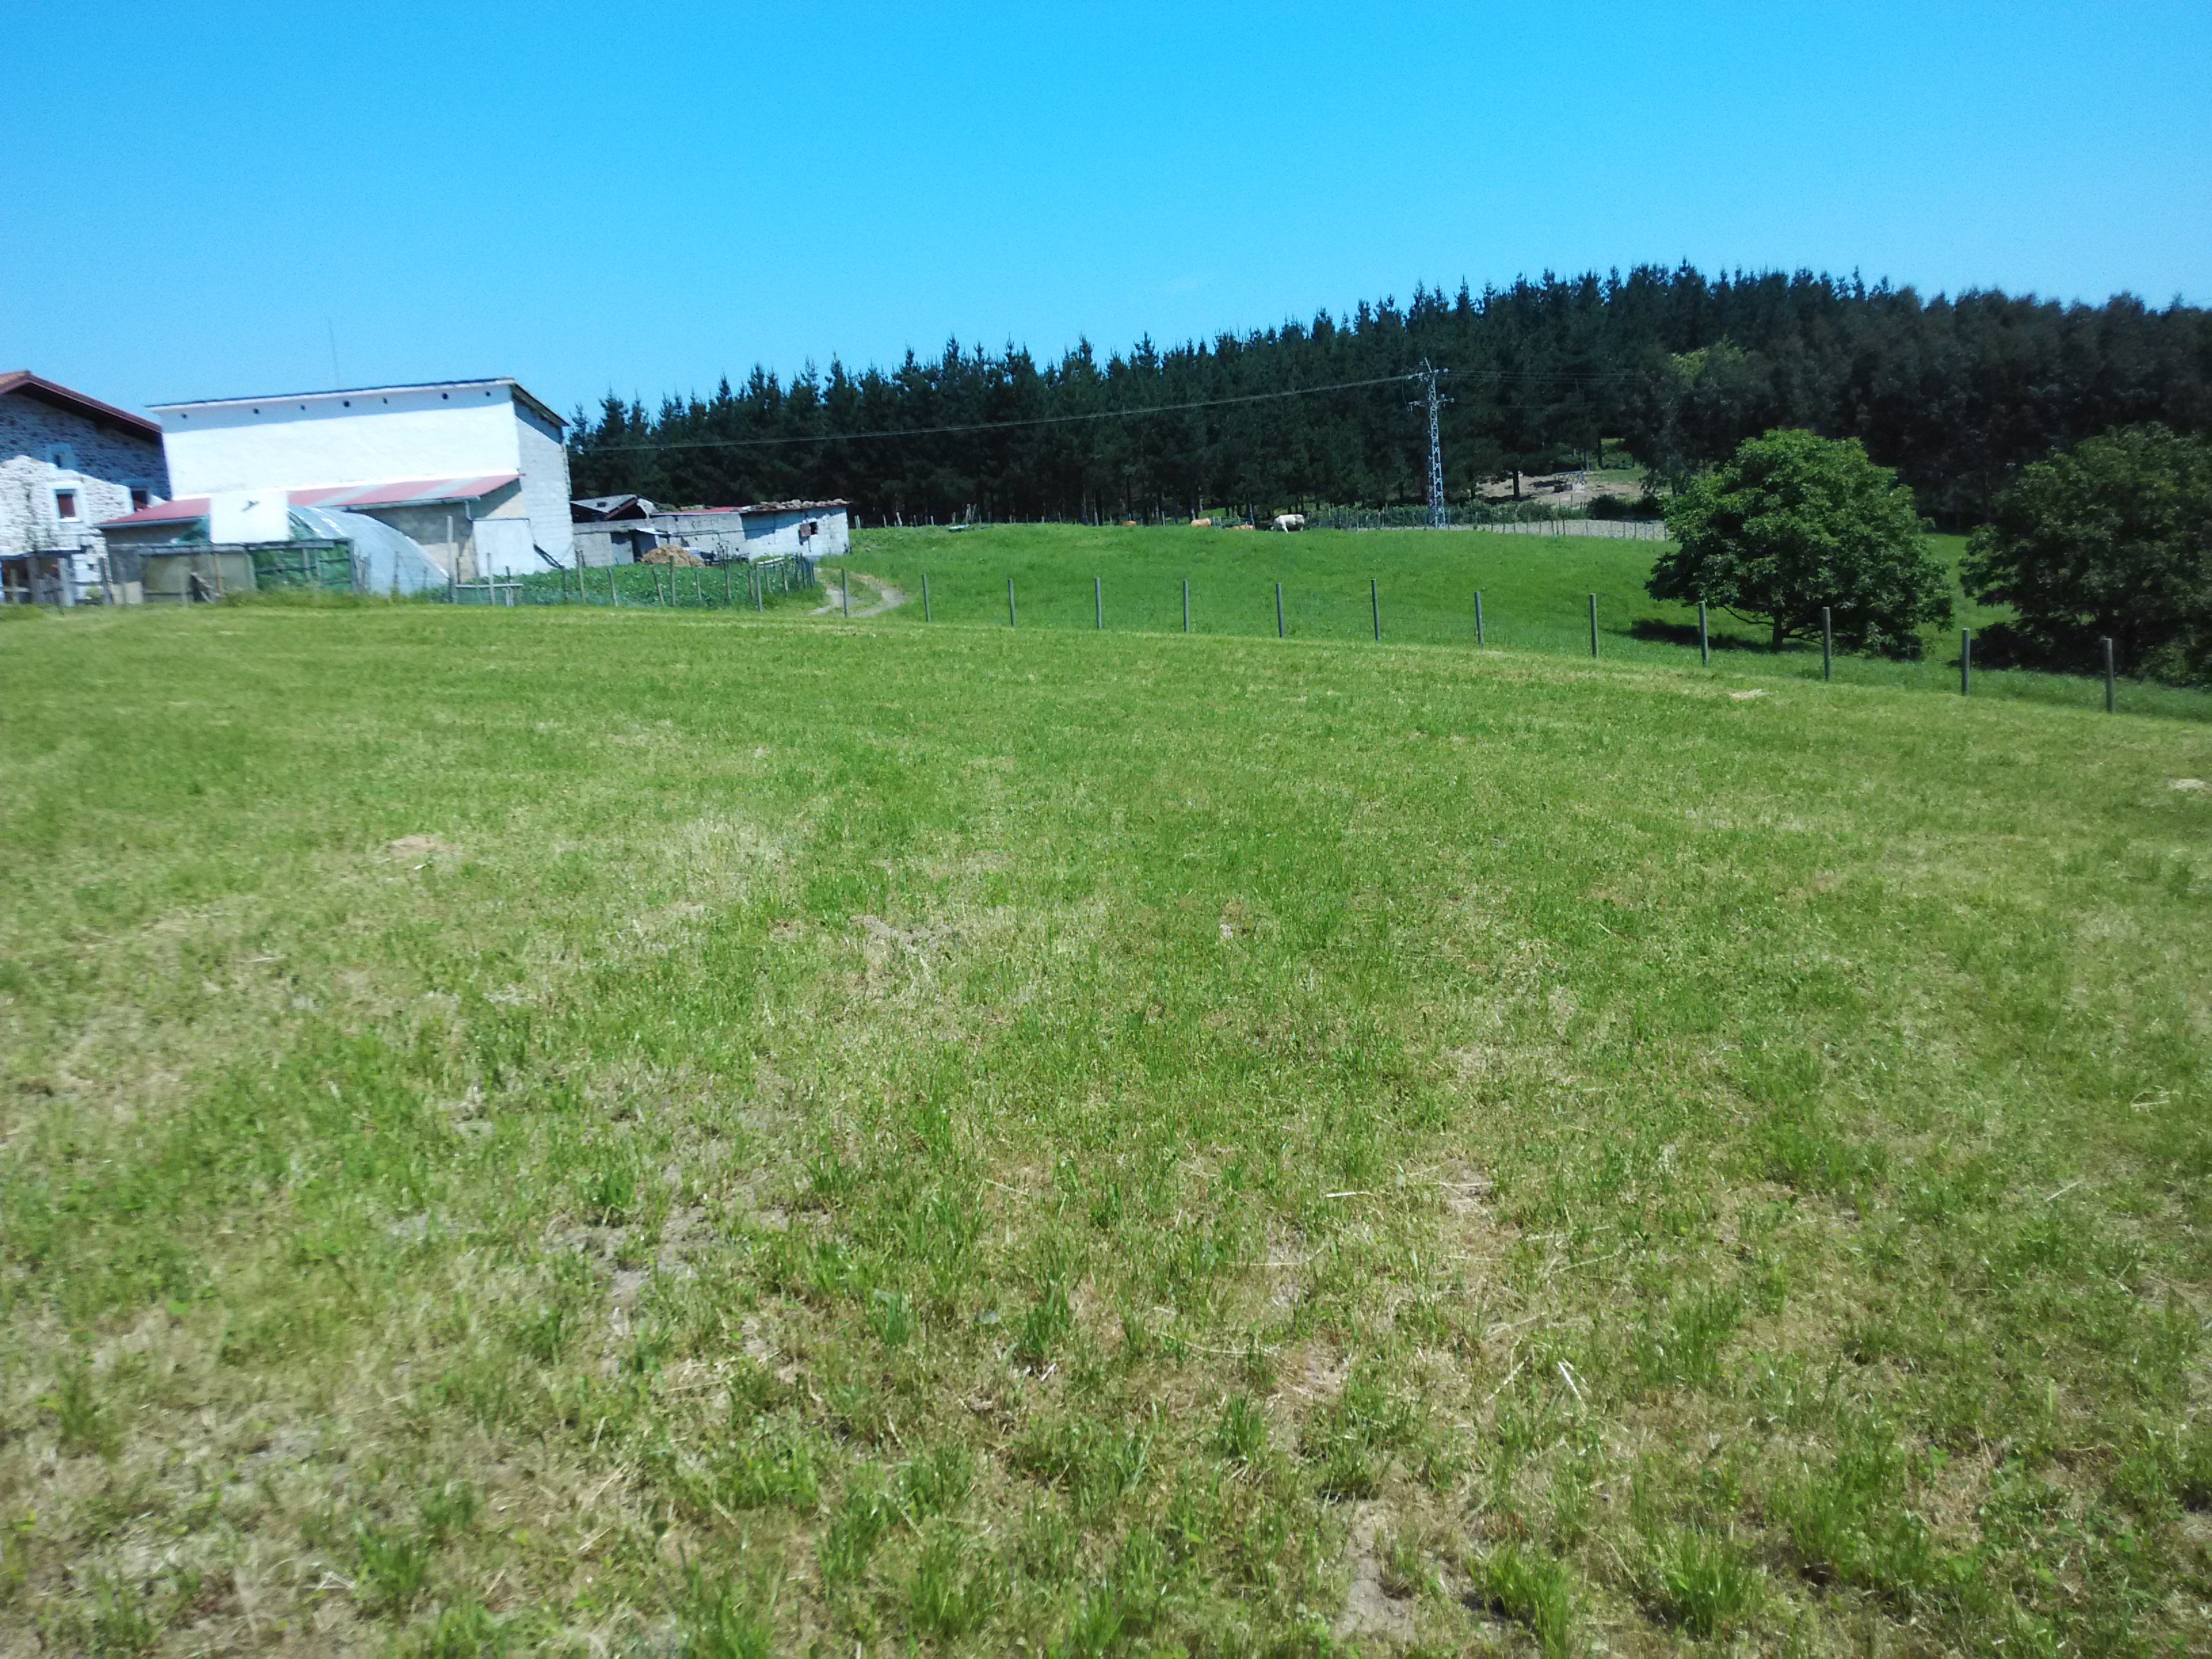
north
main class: Grassland
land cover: Grassland without tree/shrub cover
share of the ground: > 75 %
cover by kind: herbaceous plants 100 %
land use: Agriculture (excluding fallow land and kitchen gardens)
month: June
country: ES
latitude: 43.2502
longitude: -2.6050
